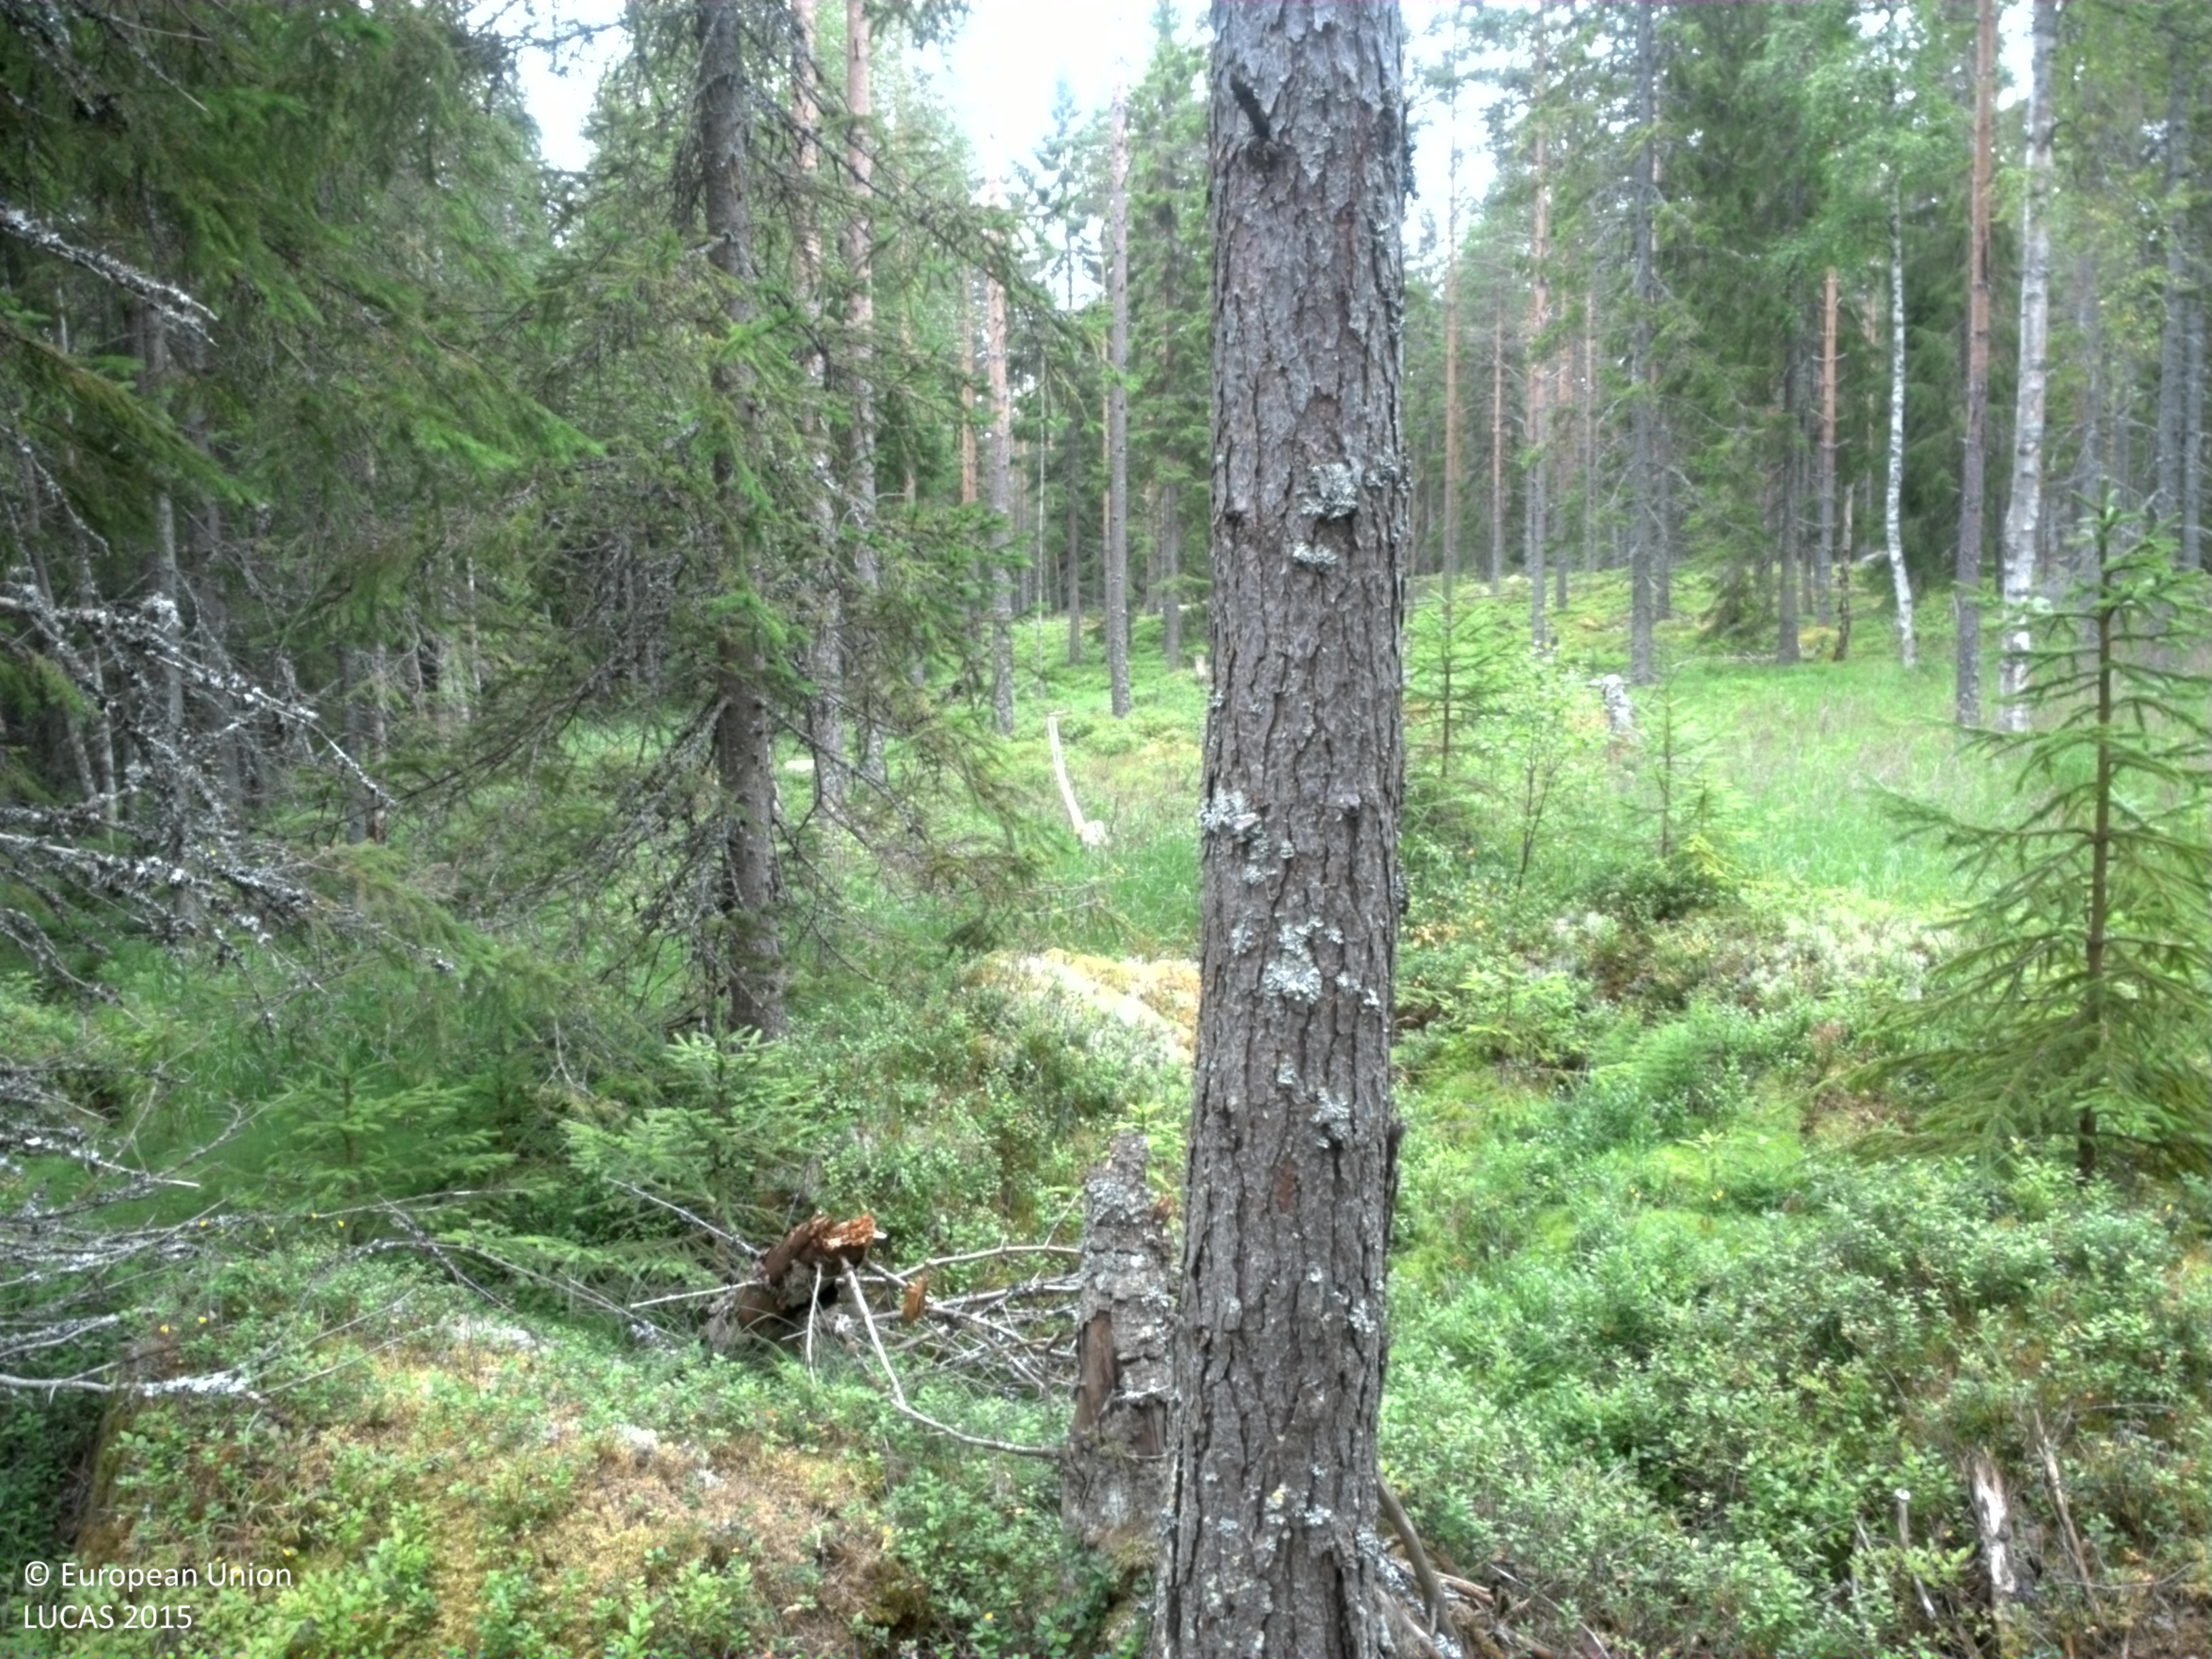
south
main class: Woodland
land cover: Spruce dominated mixed woodland
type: boreal forest
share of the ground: 50 - 75 %
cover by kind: coniferous forest trees 45 %, shrubs 20 %, broadleaved forest trees 15 %, herbaceous plants 15 %, lichens and mosses 5 %
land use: Forestry
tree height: > 5 m
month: August
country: SE
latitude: 60.1926
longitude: 14.1195
